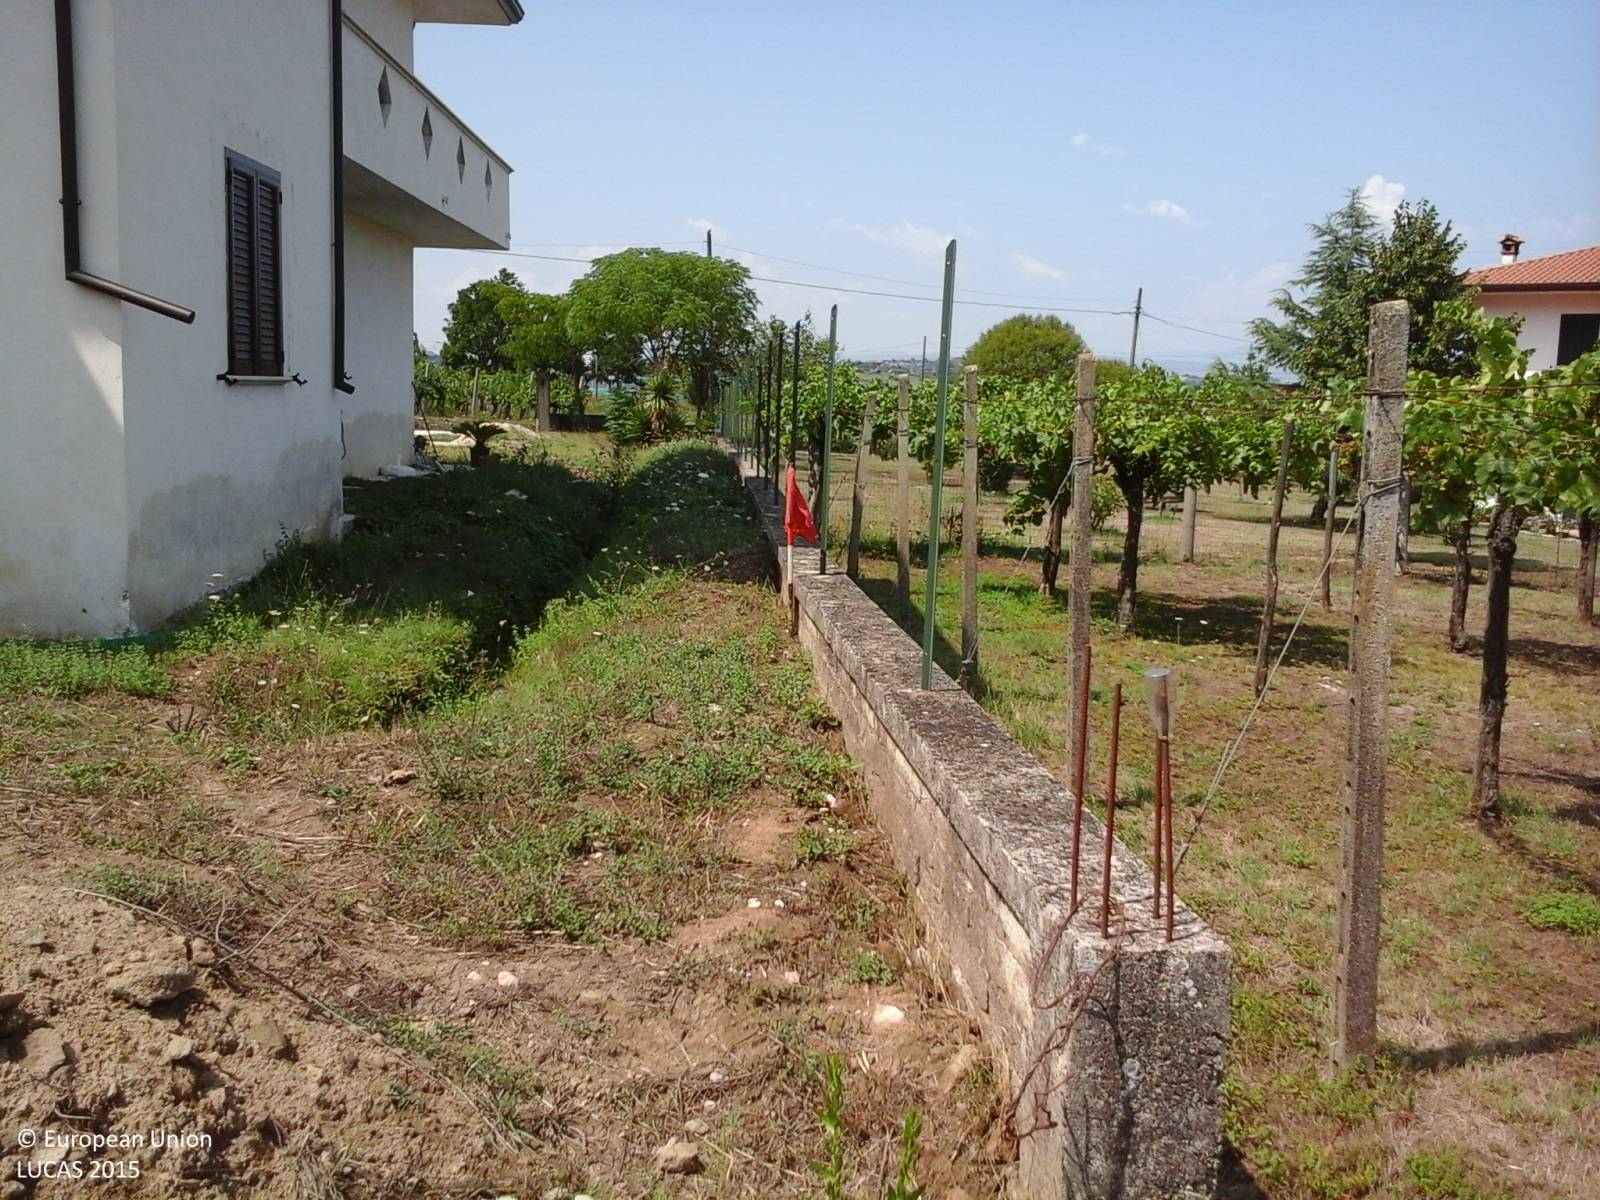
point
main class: Cropland
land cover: Vineyards
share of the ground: > 75 %
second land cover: Spontaneously vegetated surfaces
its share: > 75 %
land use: Agriculture (excluding fallow land and kitchen gardens)
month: August
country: IT
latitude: 41.5307
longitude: 13.3788
